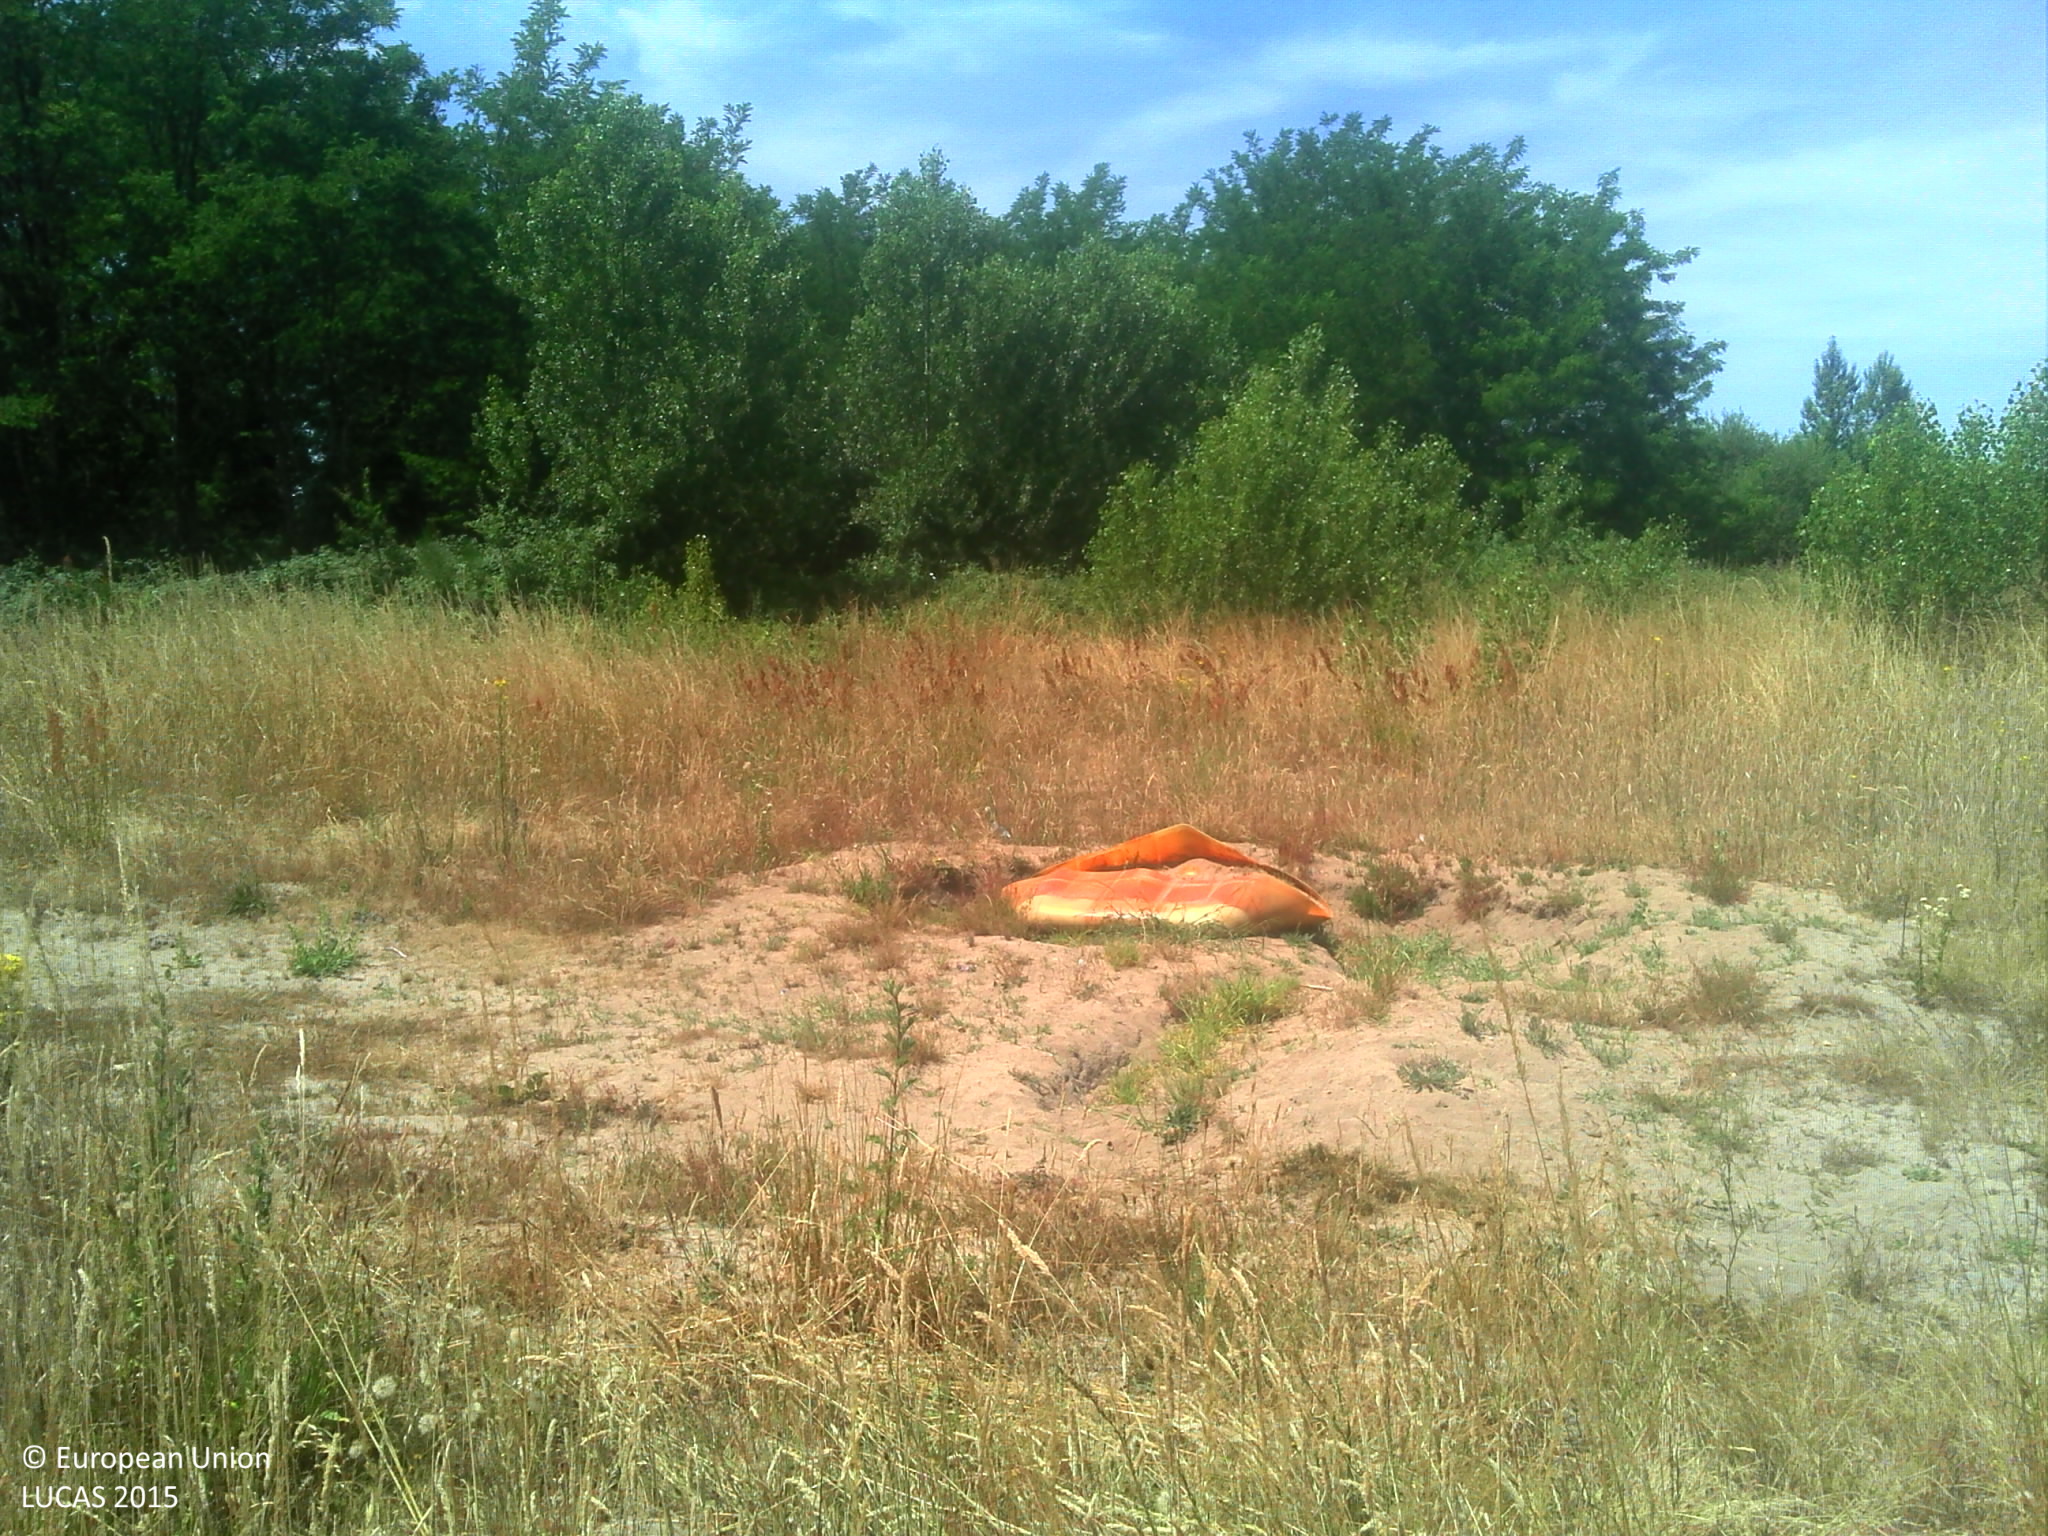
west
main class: Grassland
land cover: Spontaneously vegetated surfaces
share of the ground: > 75 %
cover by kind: herbaceous plants 60 %, unconsolidated bare surface 40 %
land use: Semi-natural and natural areas not in use
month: June
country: FR
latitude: 47.2847
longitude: 1.5653
